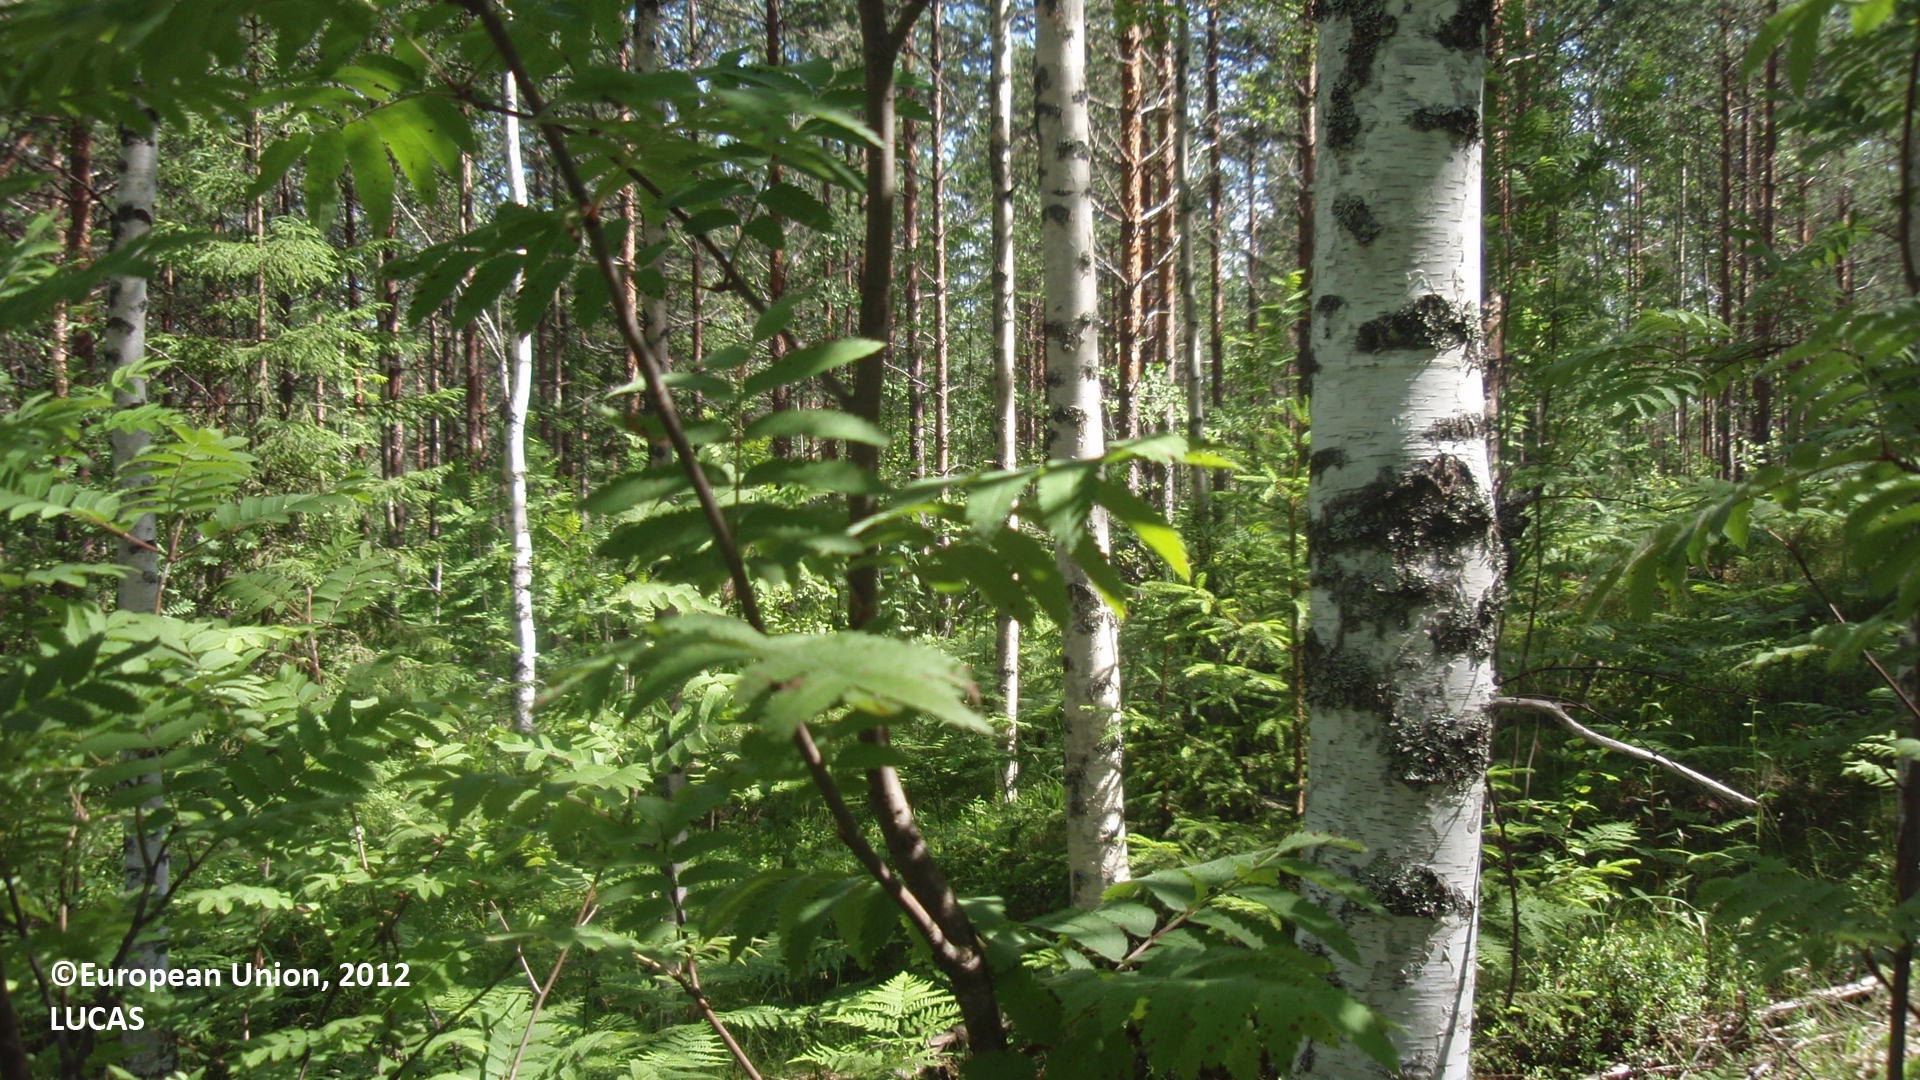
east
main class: Woodland
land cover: Other mixed woodland
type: boreal forest
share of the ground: > 75 %
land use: Forestry
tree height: > 5 m
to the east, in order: Other mixed woodland; Pine dominated coniferous woodland; Pine dominated mixed woodland; Ditches and canals; Paved roads, cycling and walking lanes; Grass margins; Ditches and canals; Pine dominated mixed woodland; Grass margins; Paved roads, cycling and walking lanes; Grass margins; Pine dominated coniferous woodland; Artificial constructions in urban areas
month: July
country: FI
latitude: 61.7327
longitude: 28.3173
